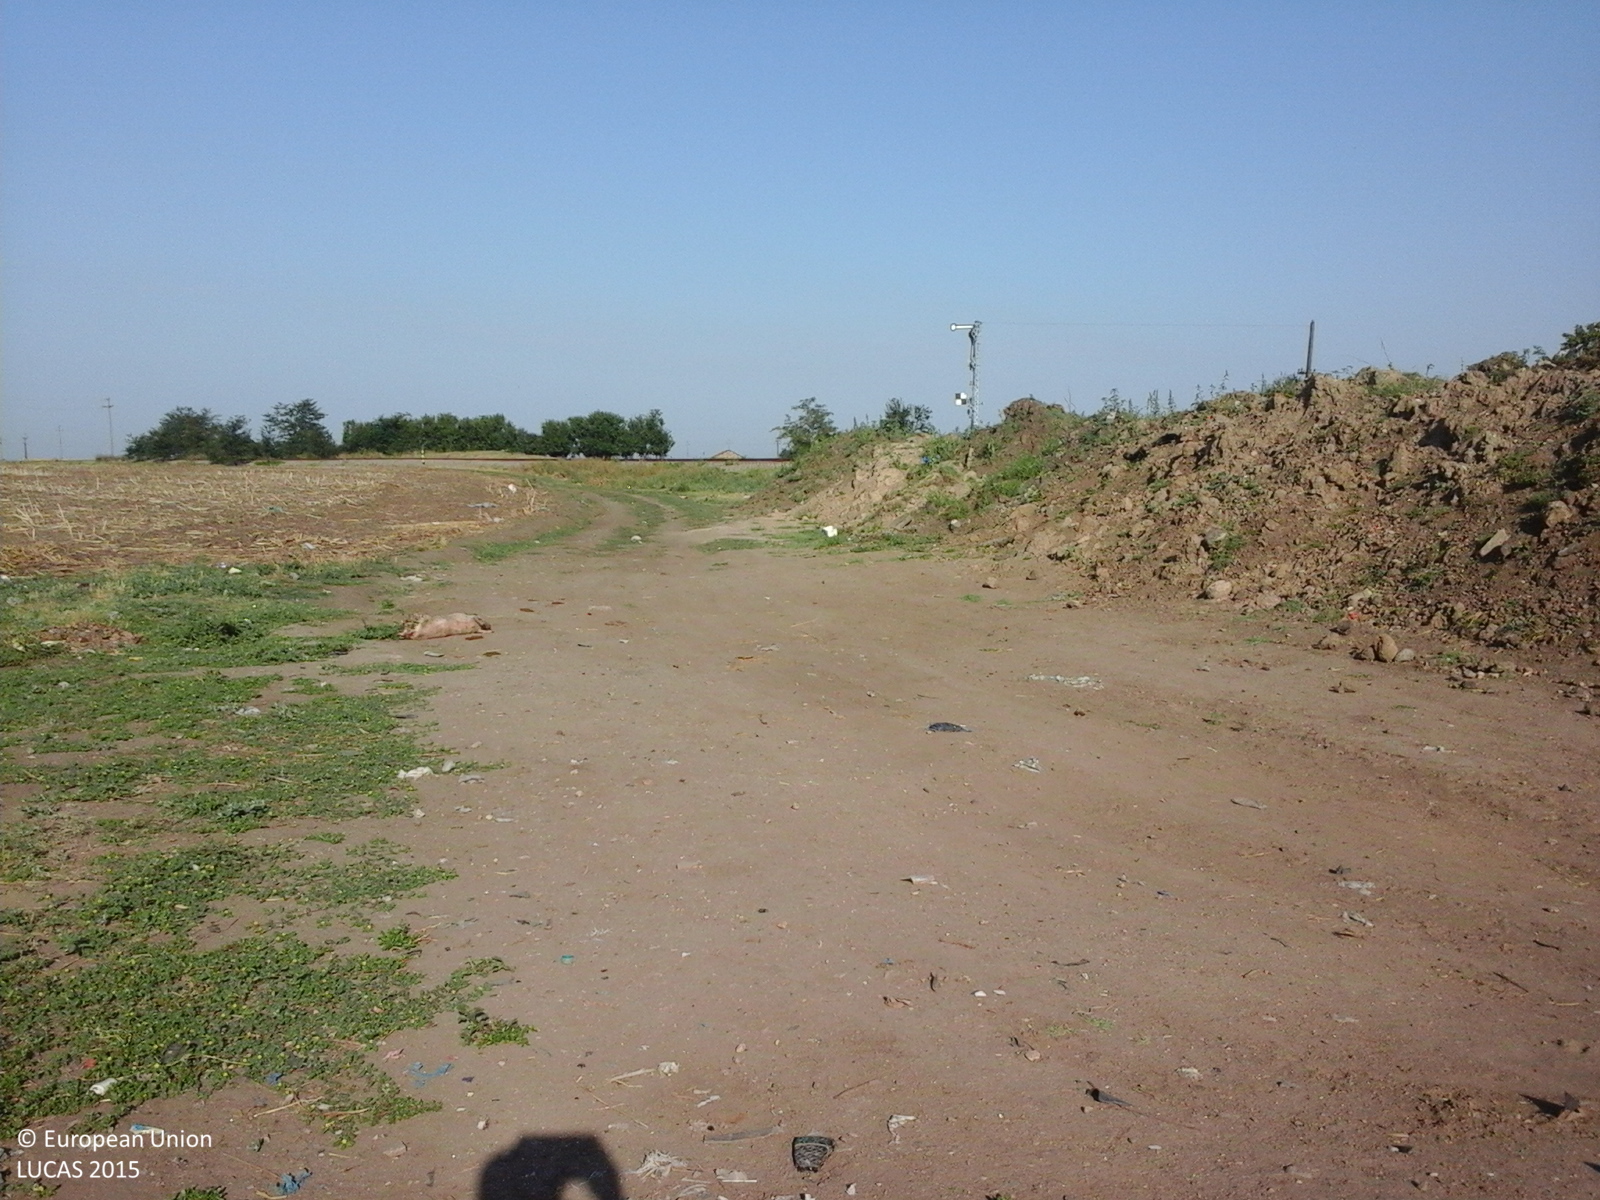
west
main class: Grassland
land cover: Spontaneously vegetated surfaces
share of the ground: 50 - 75 %
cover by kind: herbaceous plants 100 %
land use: Abandoned areas
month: August
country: RO
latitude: 44.0346
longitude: 23.1839
